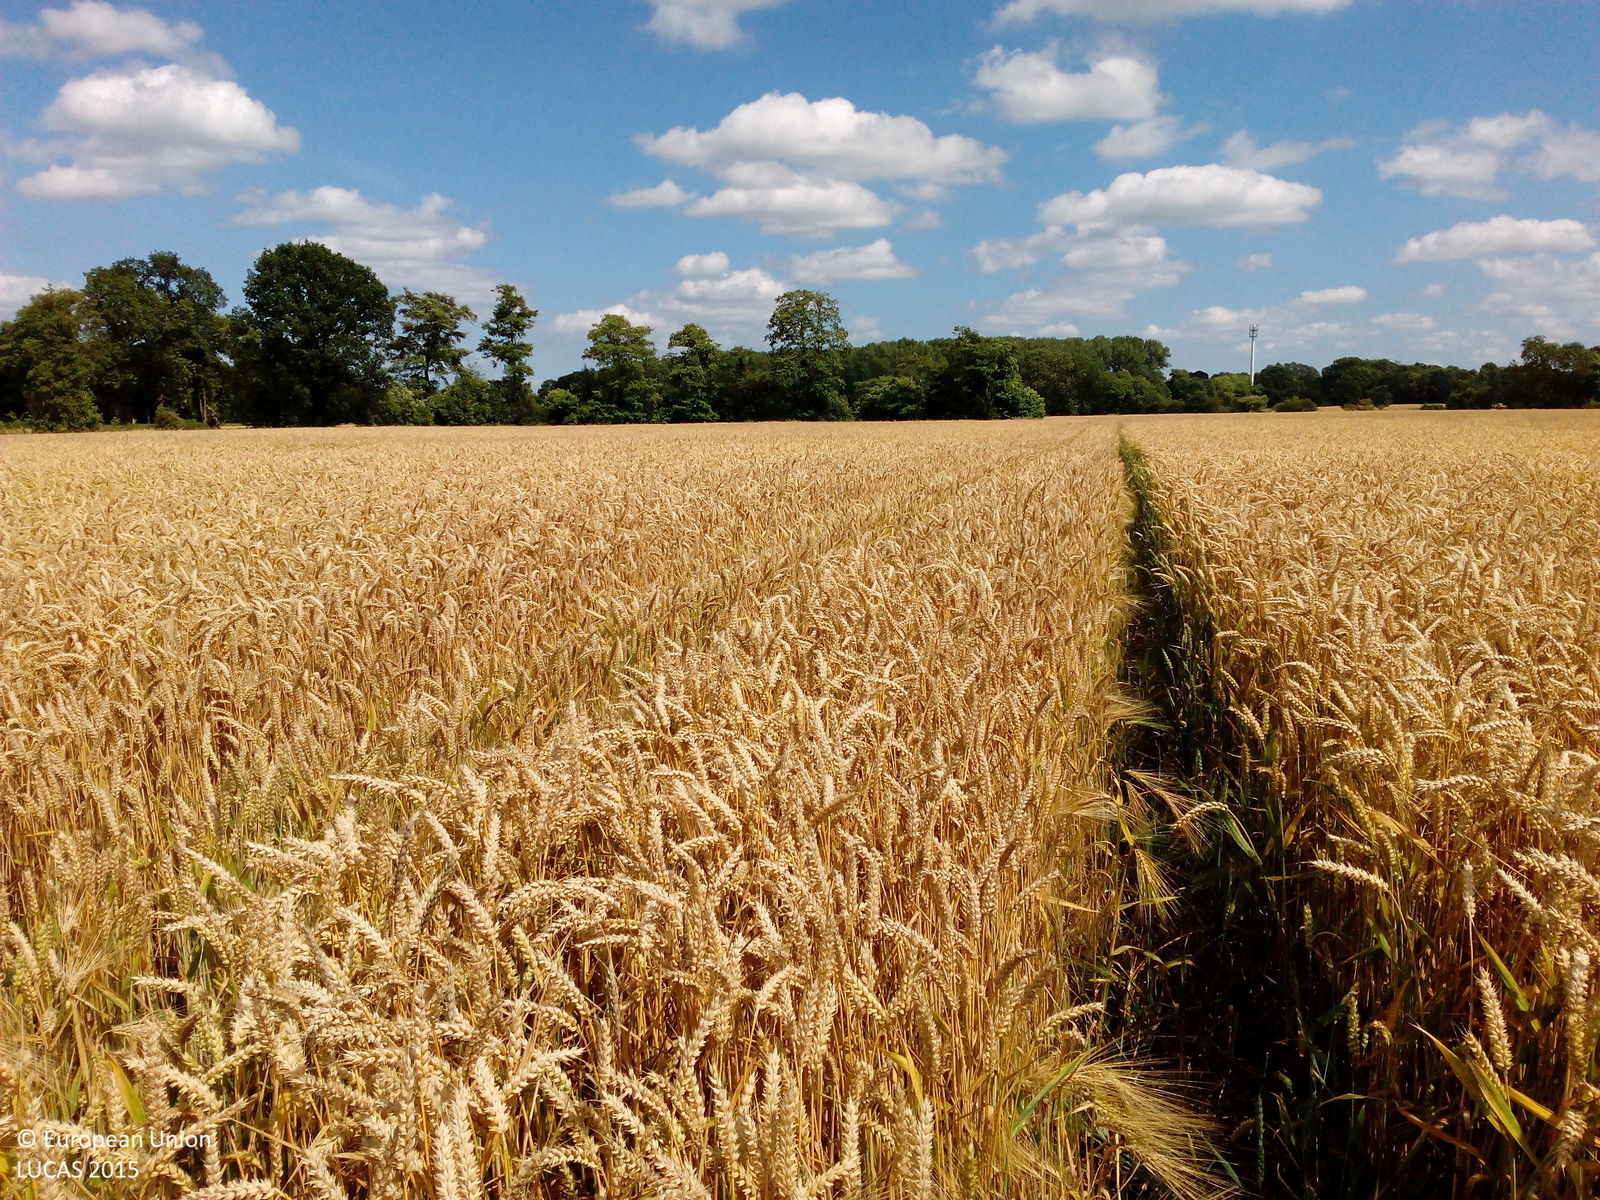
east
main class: Cropland
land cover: Common wheat
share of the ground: > 75 %
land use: Agriculture (excluding fallow land and kitchen gardens)
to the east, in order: Common wheat; Grass margins; Ditches and canals; Broadleaved woodland; Fences; Grass margins; Common wheat; Tracks; Grassland without tree/shrub cover; Inland fresh running water; Grass margins; Maize
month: July
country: DE
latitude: 53.1509
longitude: 7.9521
